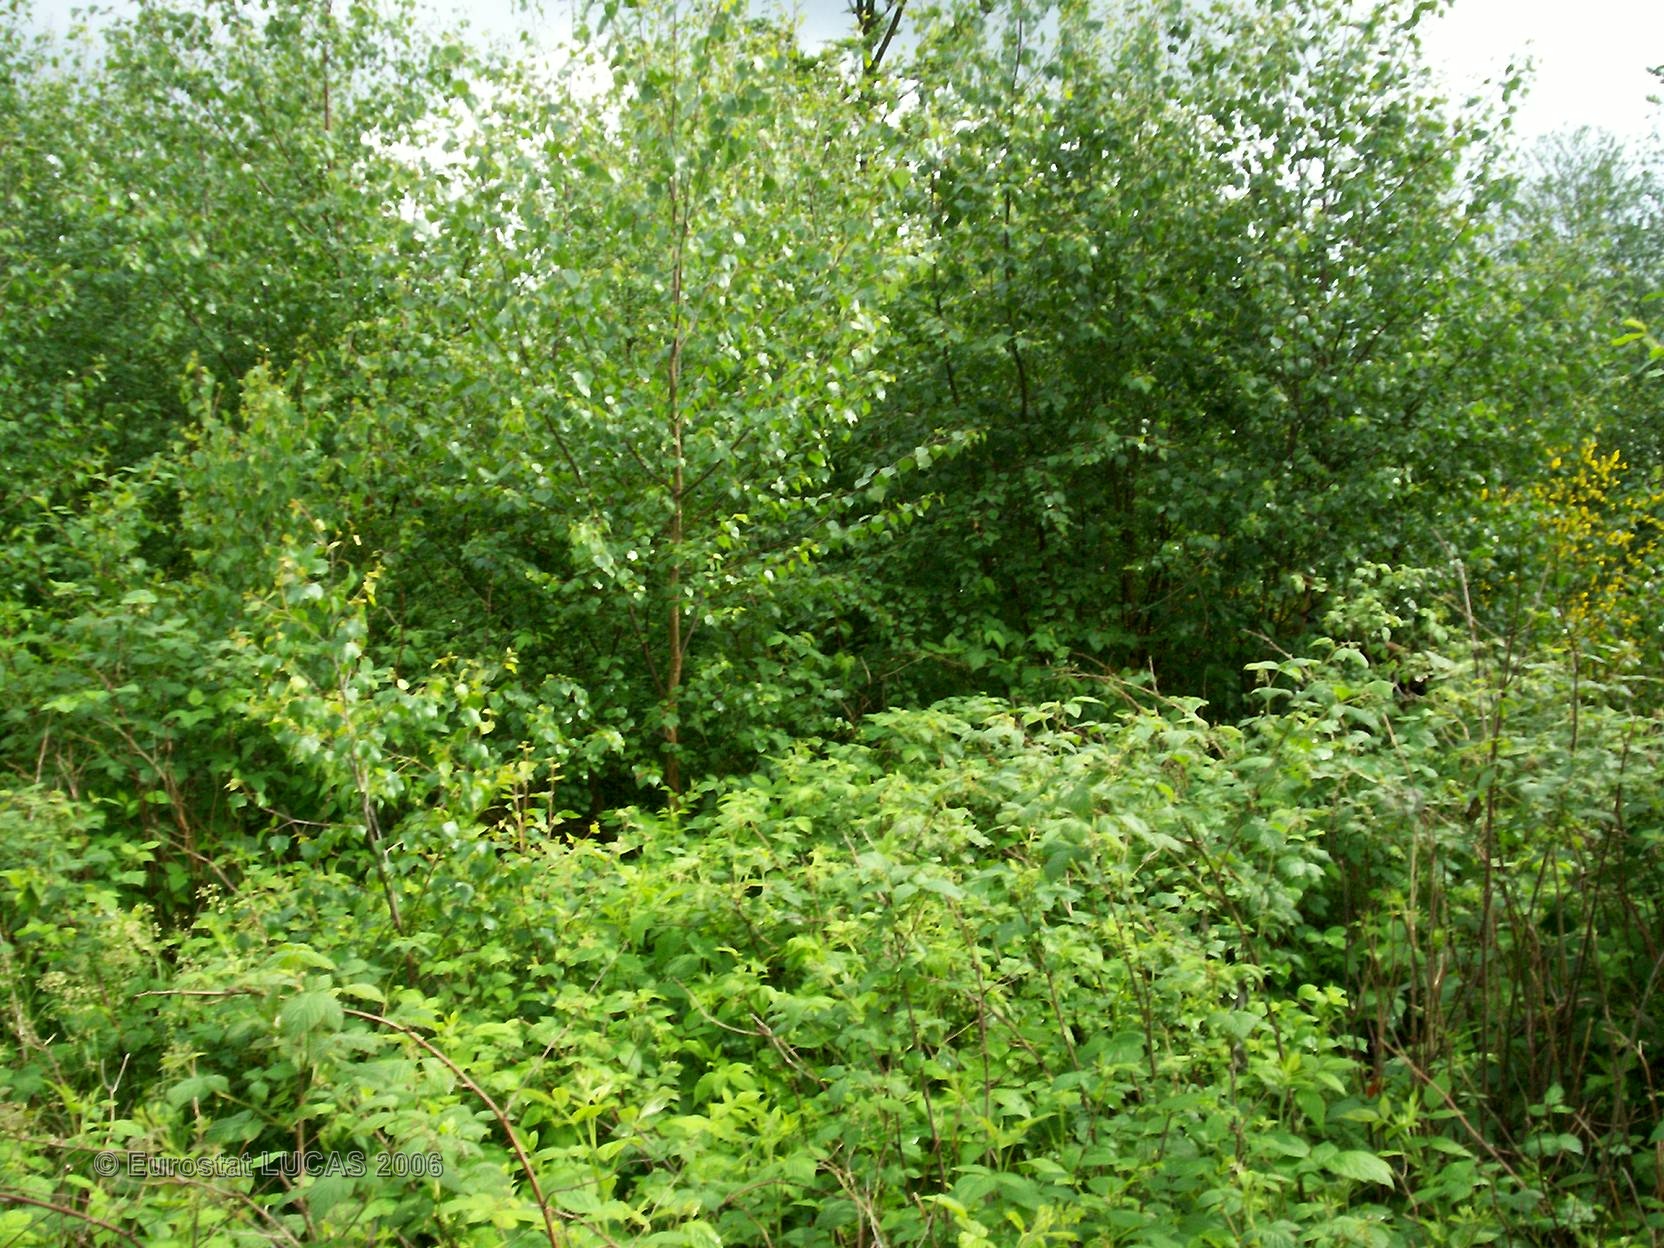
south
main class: Woodland
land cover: Broadleaved forest
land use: Forestry
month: May
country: FR
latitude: 48.5236
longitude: 6.9542
